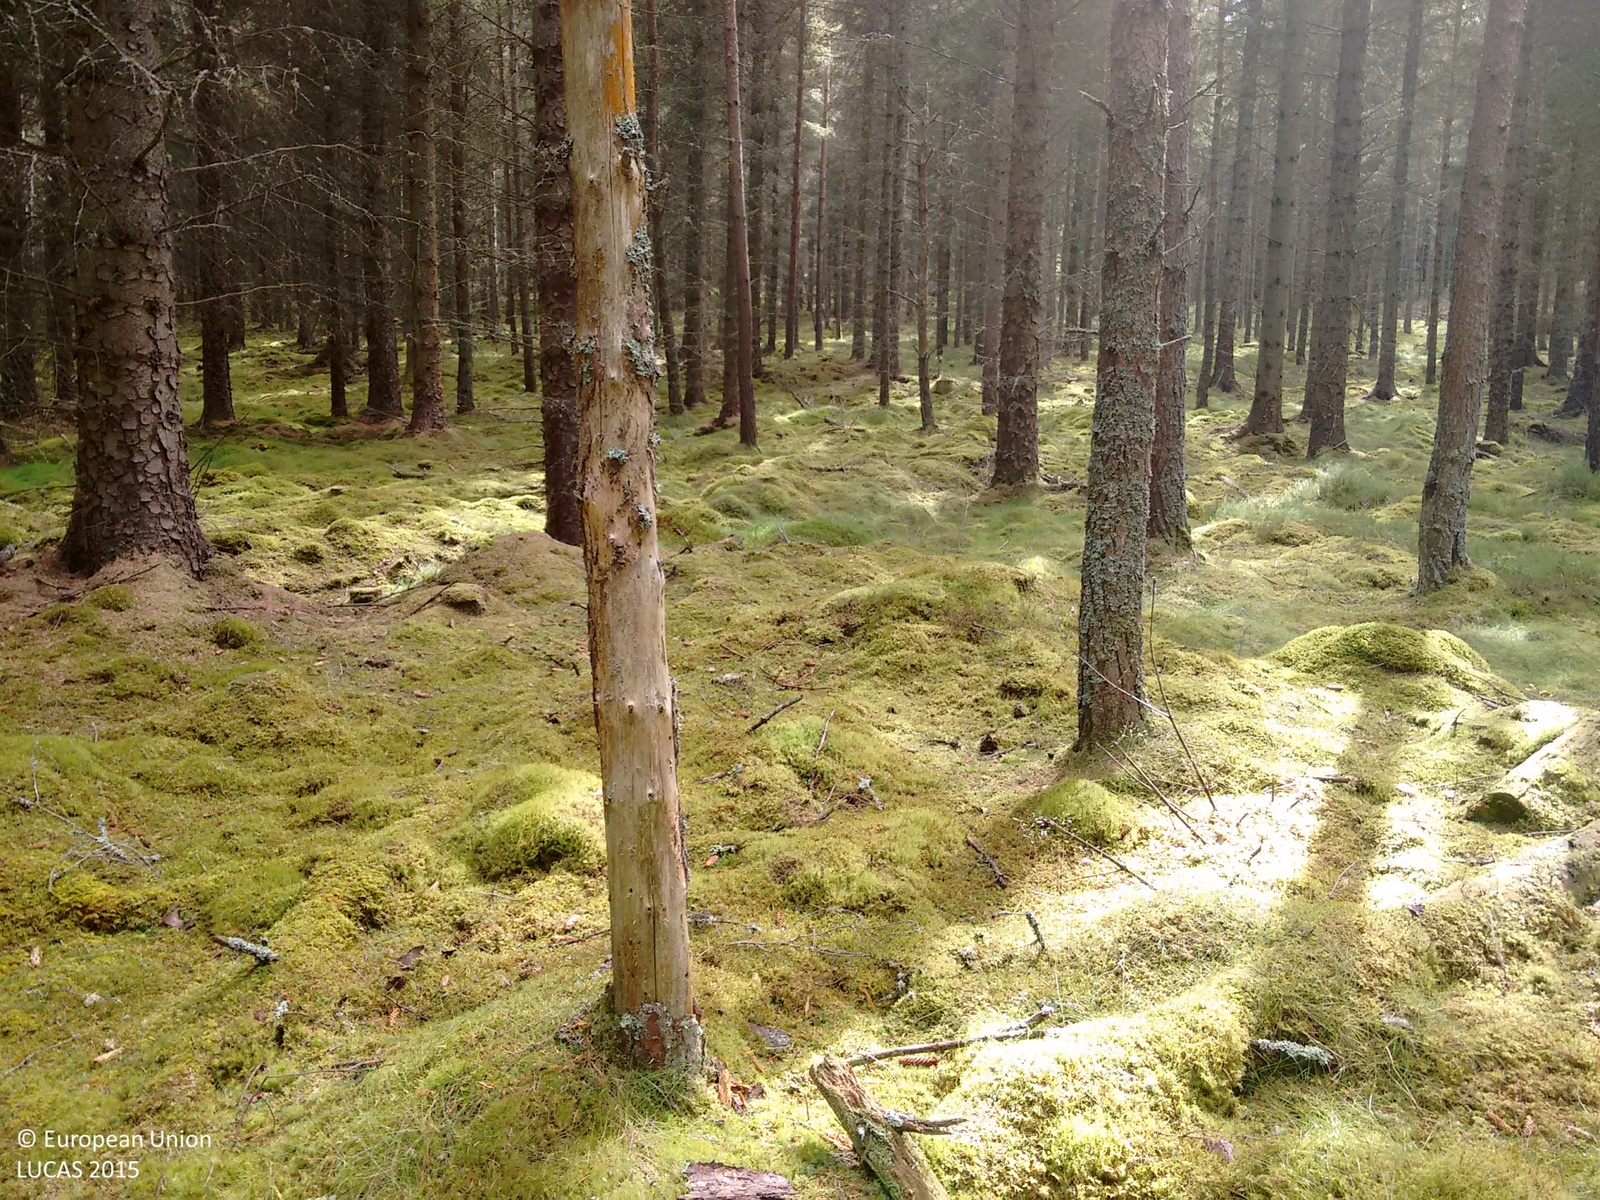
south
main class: Woodland
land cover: Spruce dominated coniferous woodland
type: exotic forest
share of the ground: > 75 %
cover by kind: coniferous forest trees 80 %, lichens and mosses 15 %, broadleaved forest trees 5 %
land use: Forestry
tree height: > 5 m
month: August
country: GB
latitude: 57.6723
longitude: -2.8504
